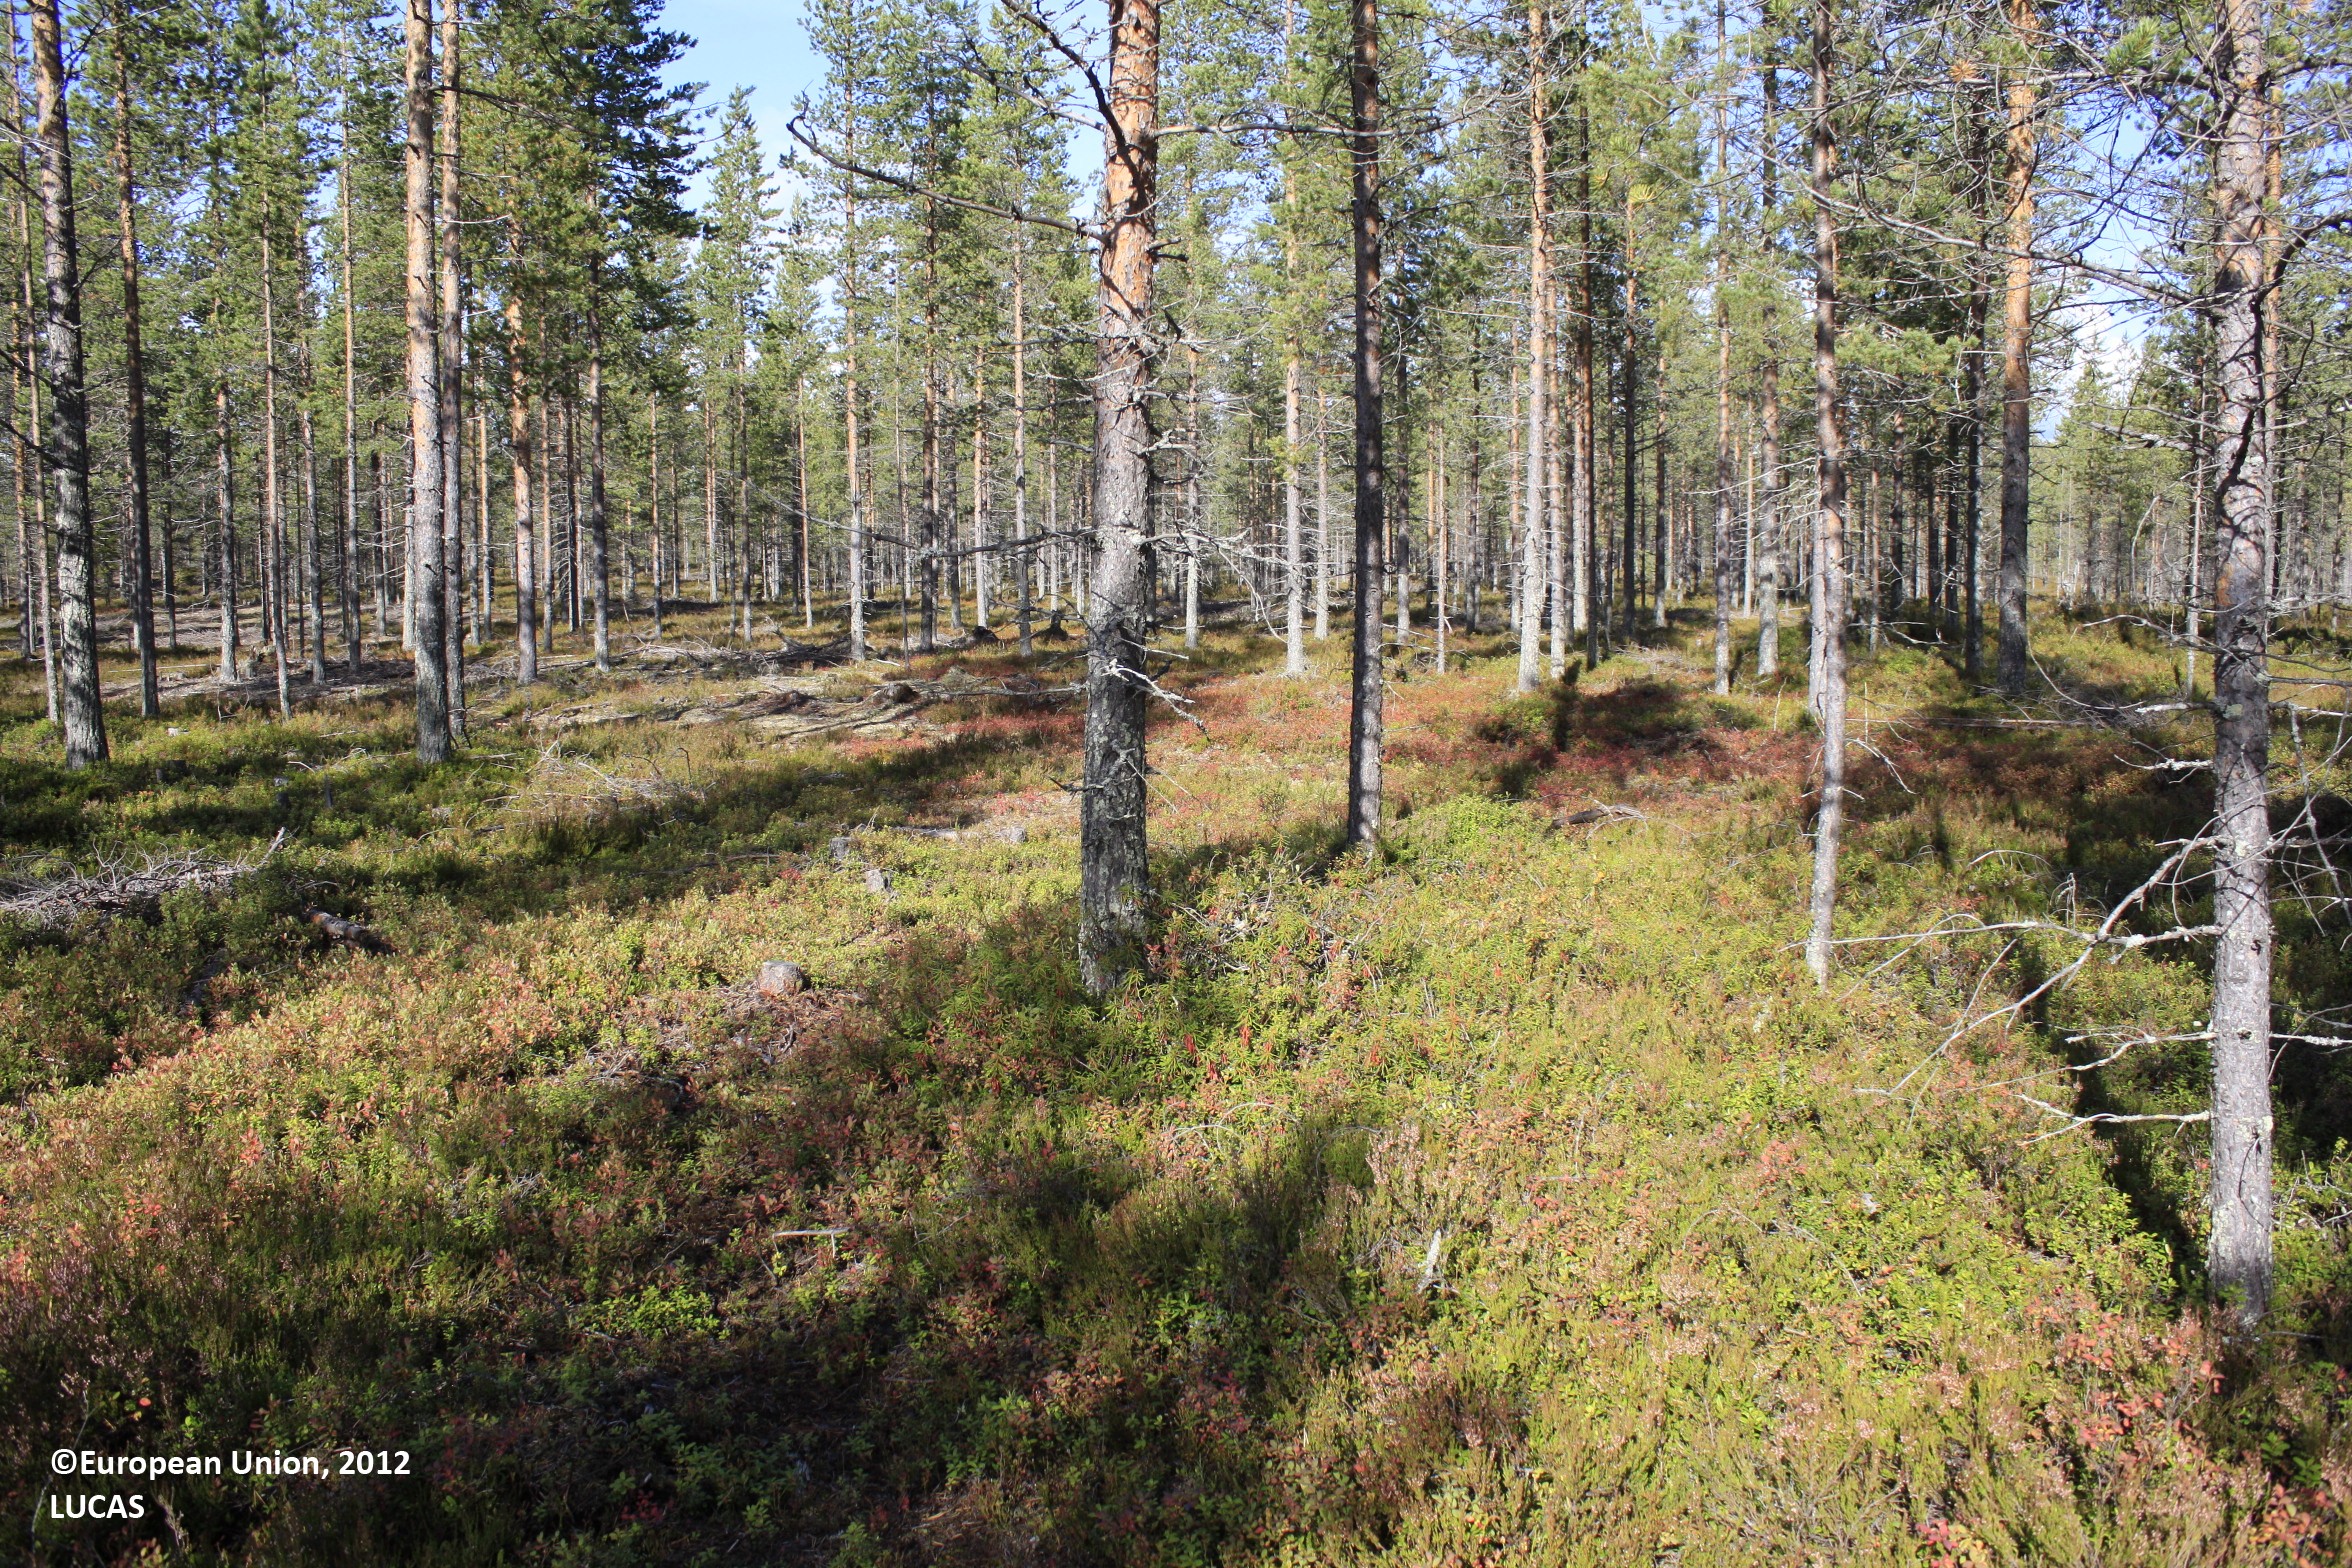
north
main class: Woodland
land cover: Pine dominated coniferous woodland
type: boreal forest
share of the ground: < 10 %
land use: Forestry
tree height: > 5 m
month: September
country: FI
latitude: 65.5018
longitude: 26.9497
